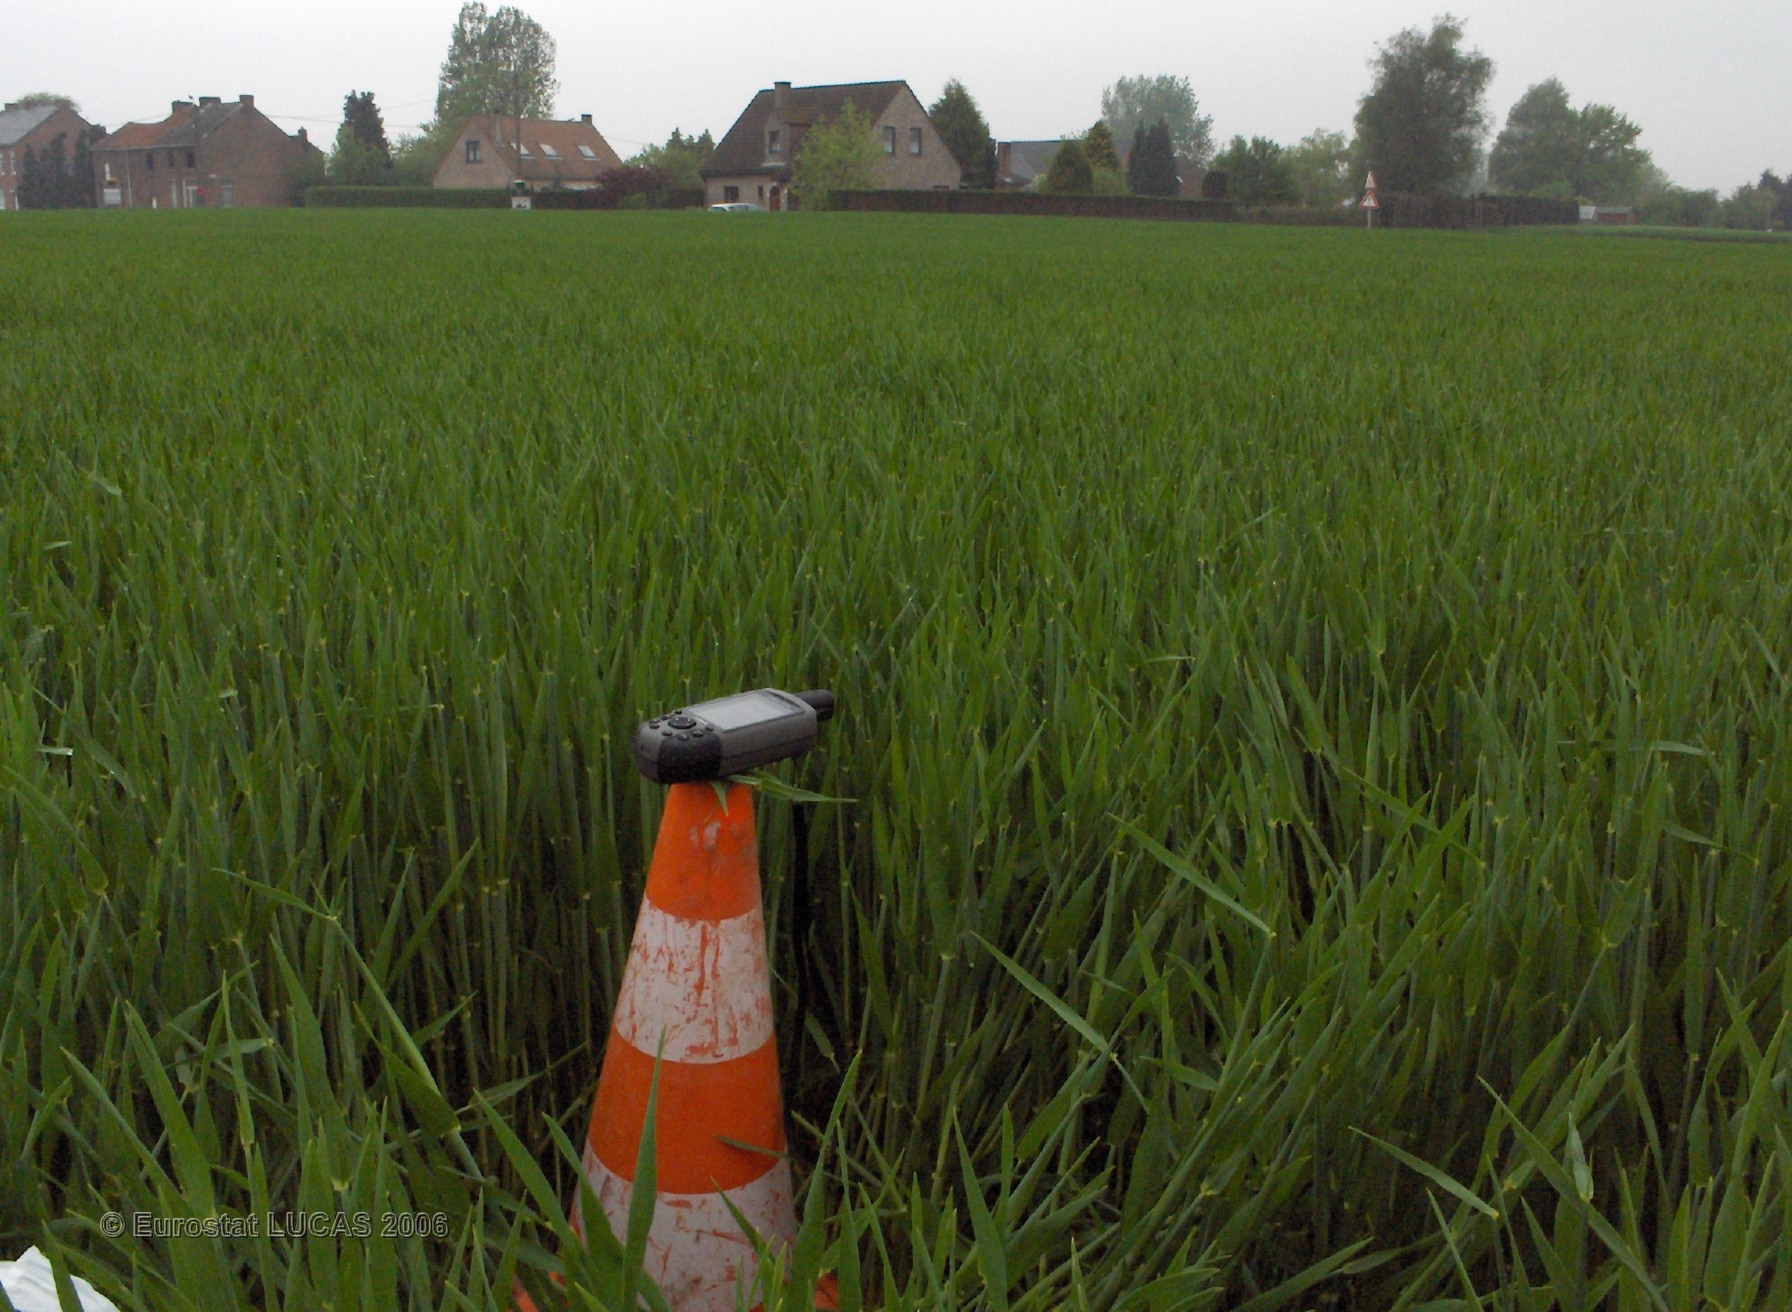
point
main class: Cropland
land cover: Common wheat
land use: Agriculture (excluding fallow land and kitchen gardens)
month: May
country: BE
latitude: 50.5551
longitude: 4.4769
